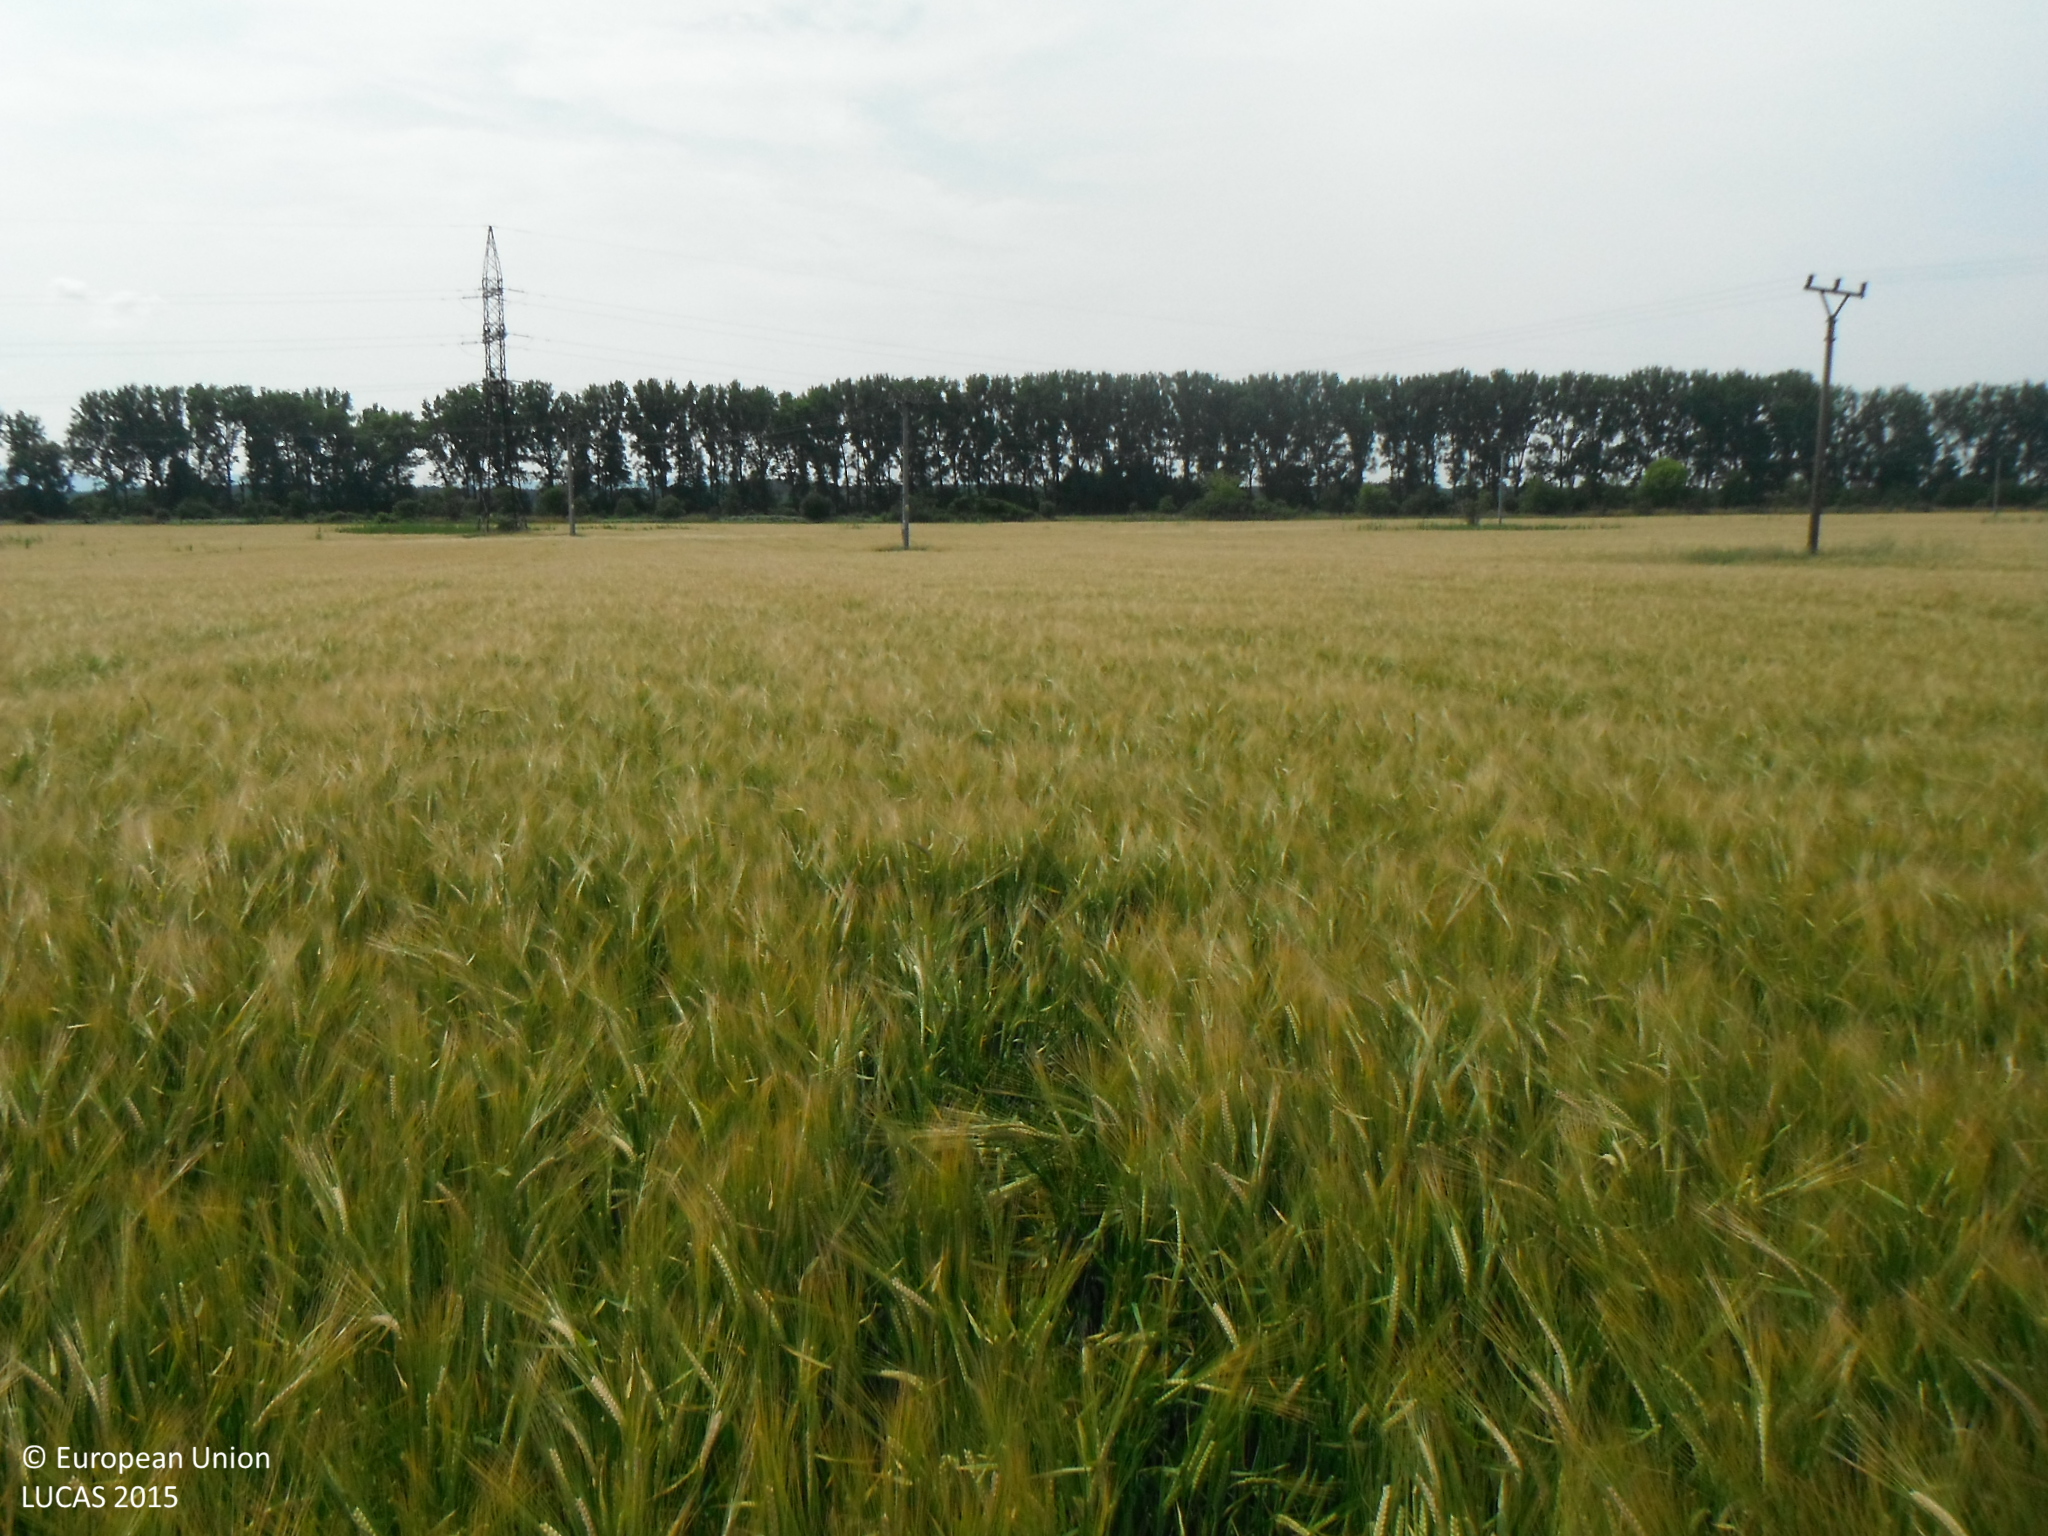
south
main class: Cropland
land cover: Barley
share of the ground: > 75 %
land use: Agriculture (excluding fallow land and kitchen gardens)
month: June
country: SK
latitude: 48.6713
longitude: 17.2475
